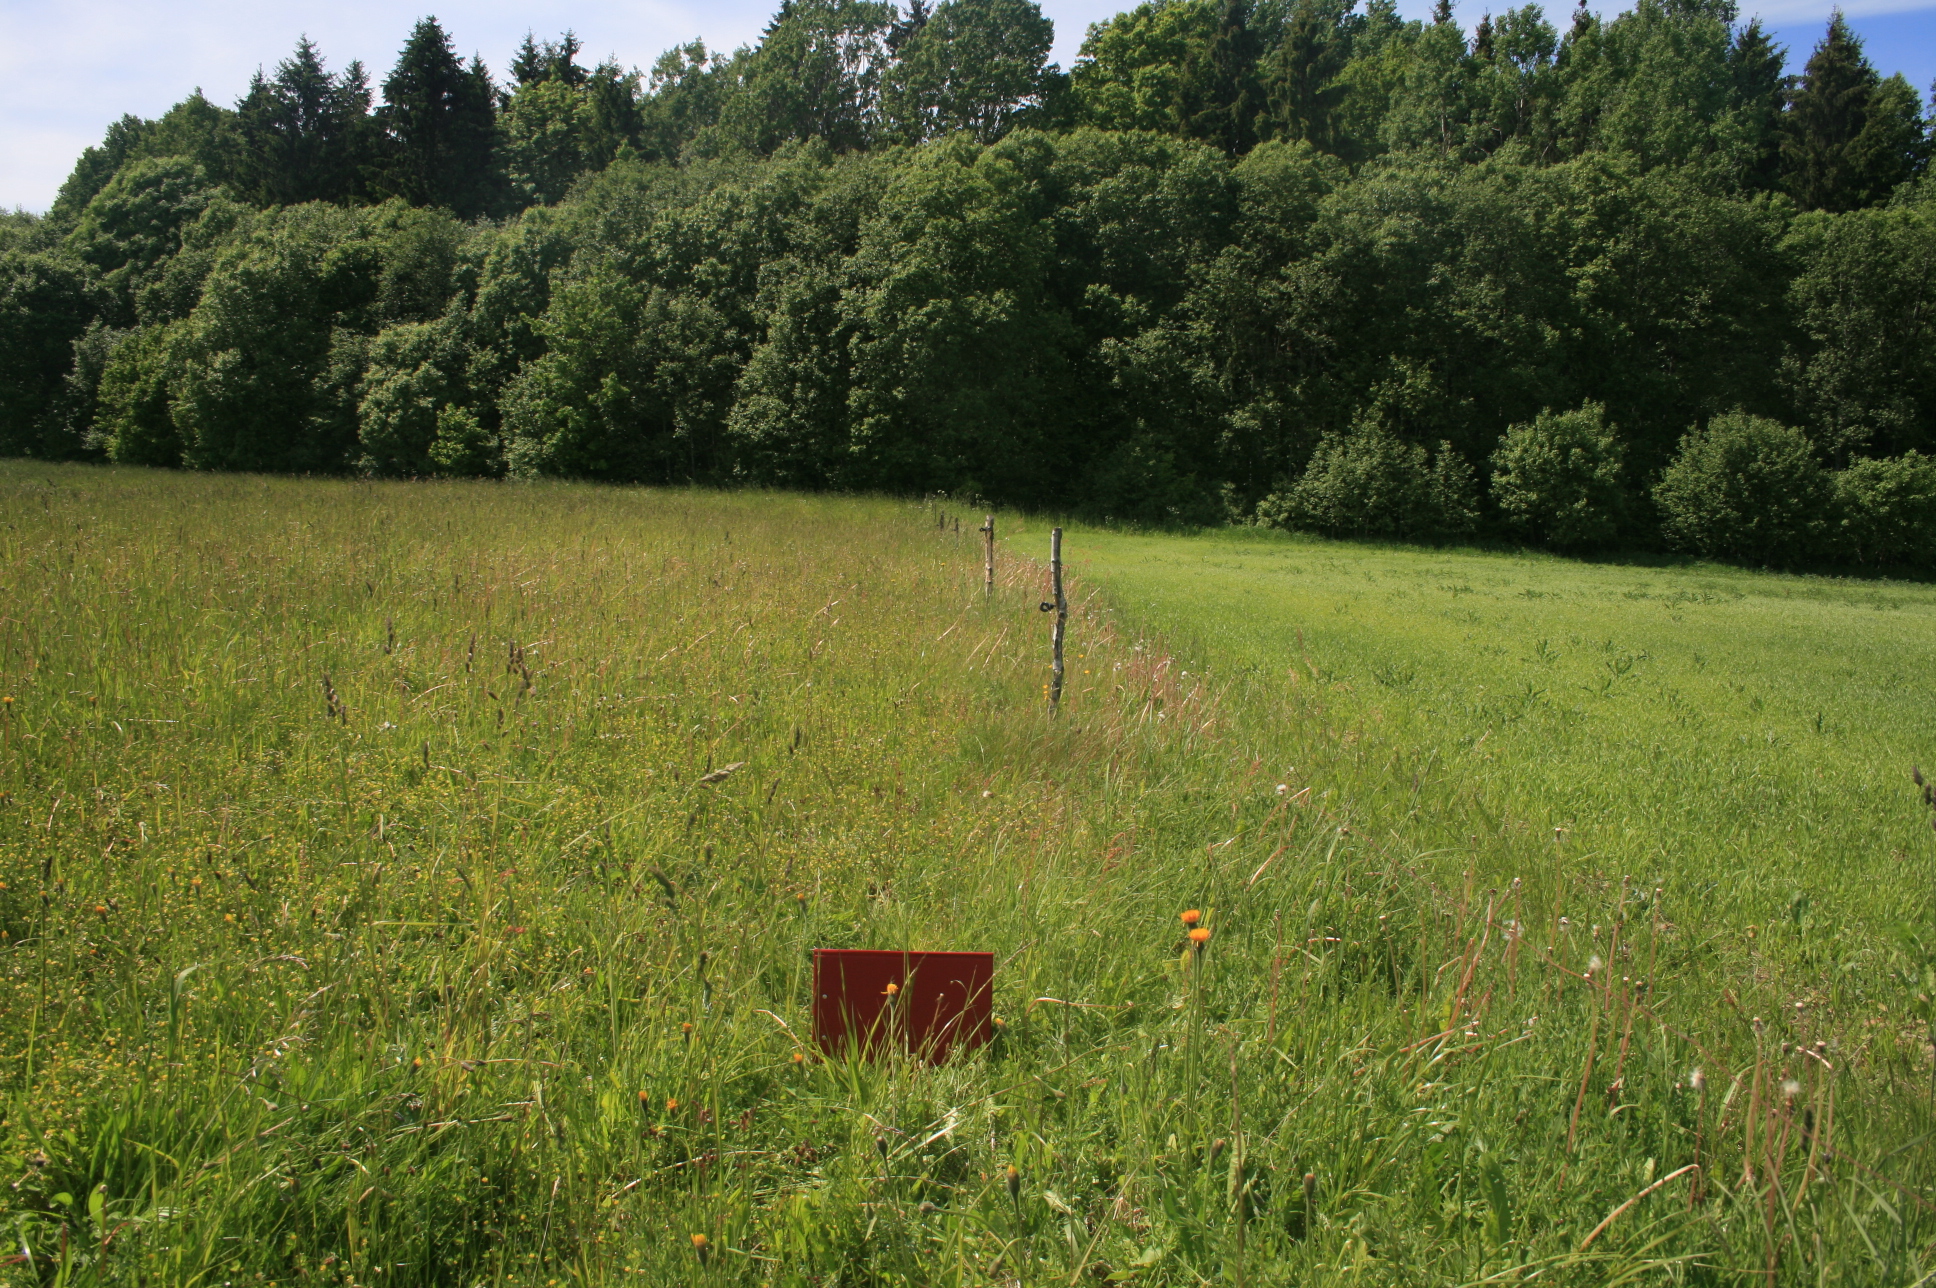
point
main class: Grassland
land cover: Grassland without tree/shrub cover
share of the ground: > 75 %
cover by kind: herbaceous plants 100 %
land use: Agriculture (excluding fallow land and kitchen gardens)
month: June
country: LT
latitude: 55.9297
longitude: 22.3982
